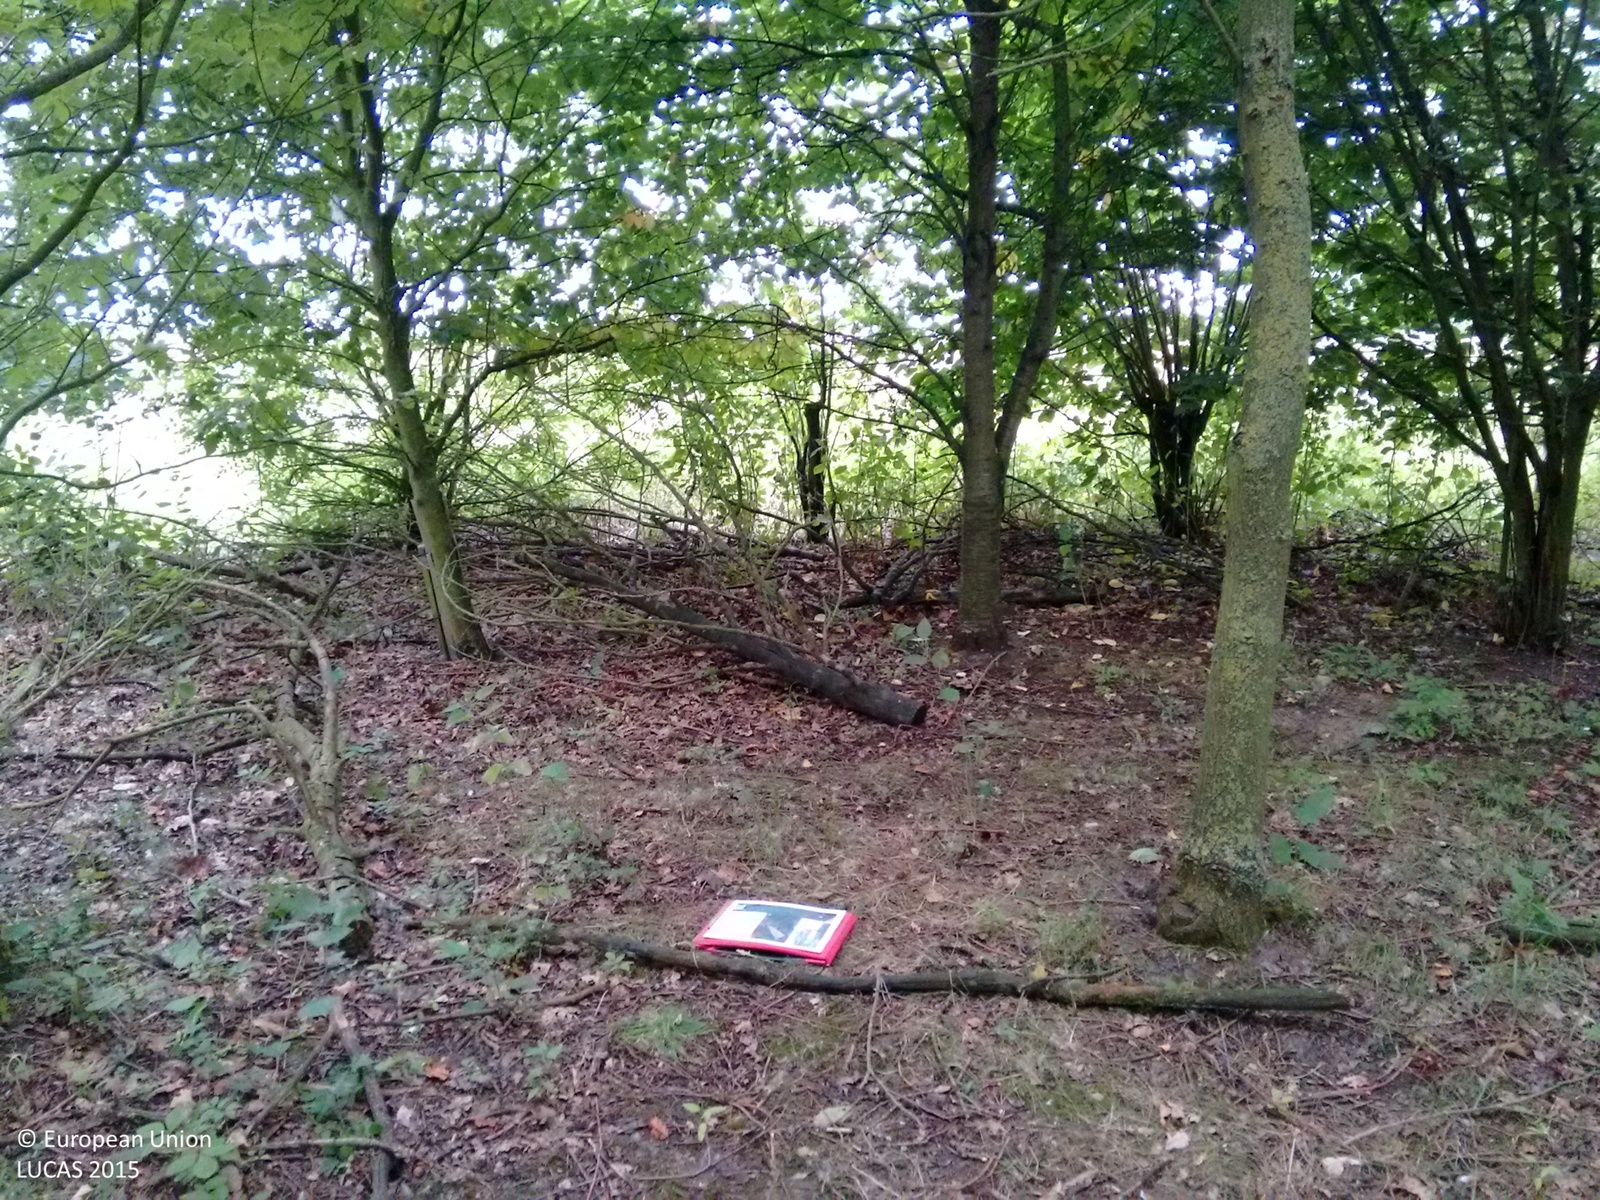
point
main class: Woodland
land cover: Other mixed woodland
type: exotic forest
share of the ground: > 75 %
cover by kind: broadleaved forest trees 60 %, coniferous forest trees 40 %
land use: Sport
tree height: > 5 m
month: August
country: GB
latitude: 52.3794
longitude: 0.3190
